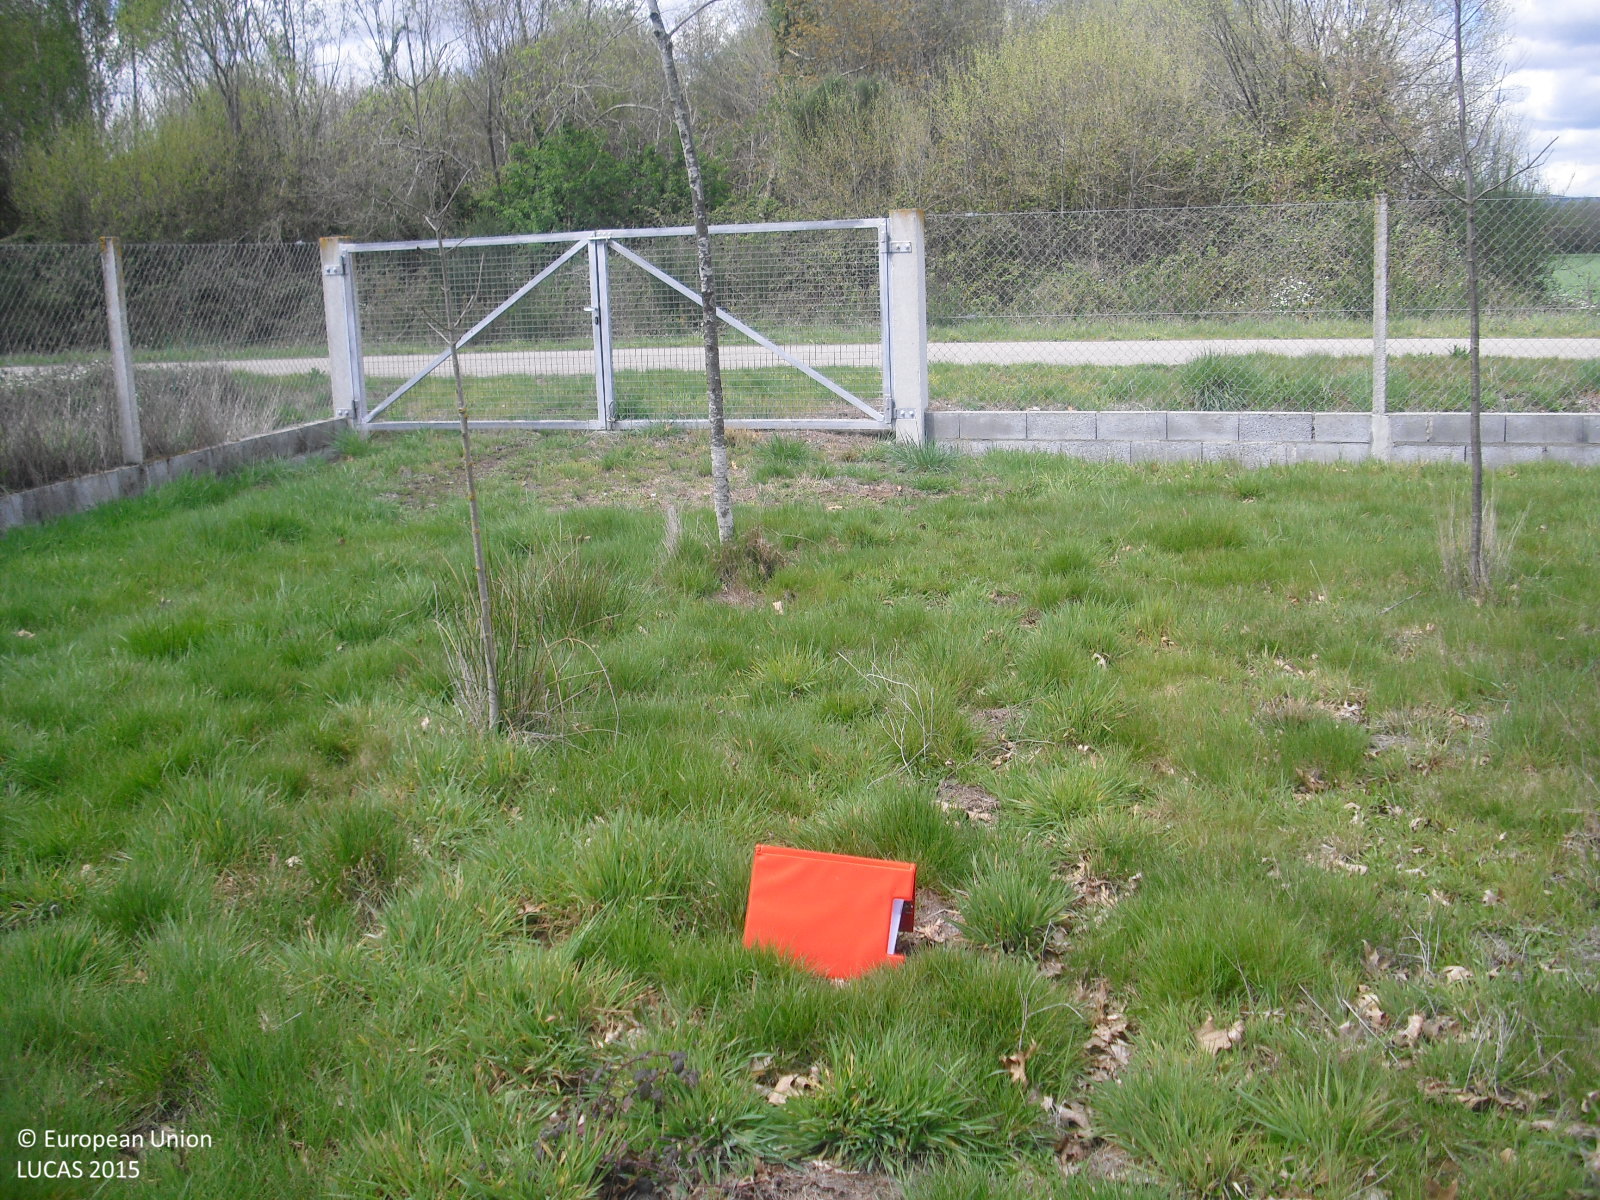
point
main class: Woodland
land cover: Broadleaved woodland
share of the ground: 10 - 25 %
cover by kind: herbaceous plants 80 %, broadleaved forest trees 20 %
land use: Forestry
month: April
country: ES
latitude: 42.0371
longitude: -7.8168
